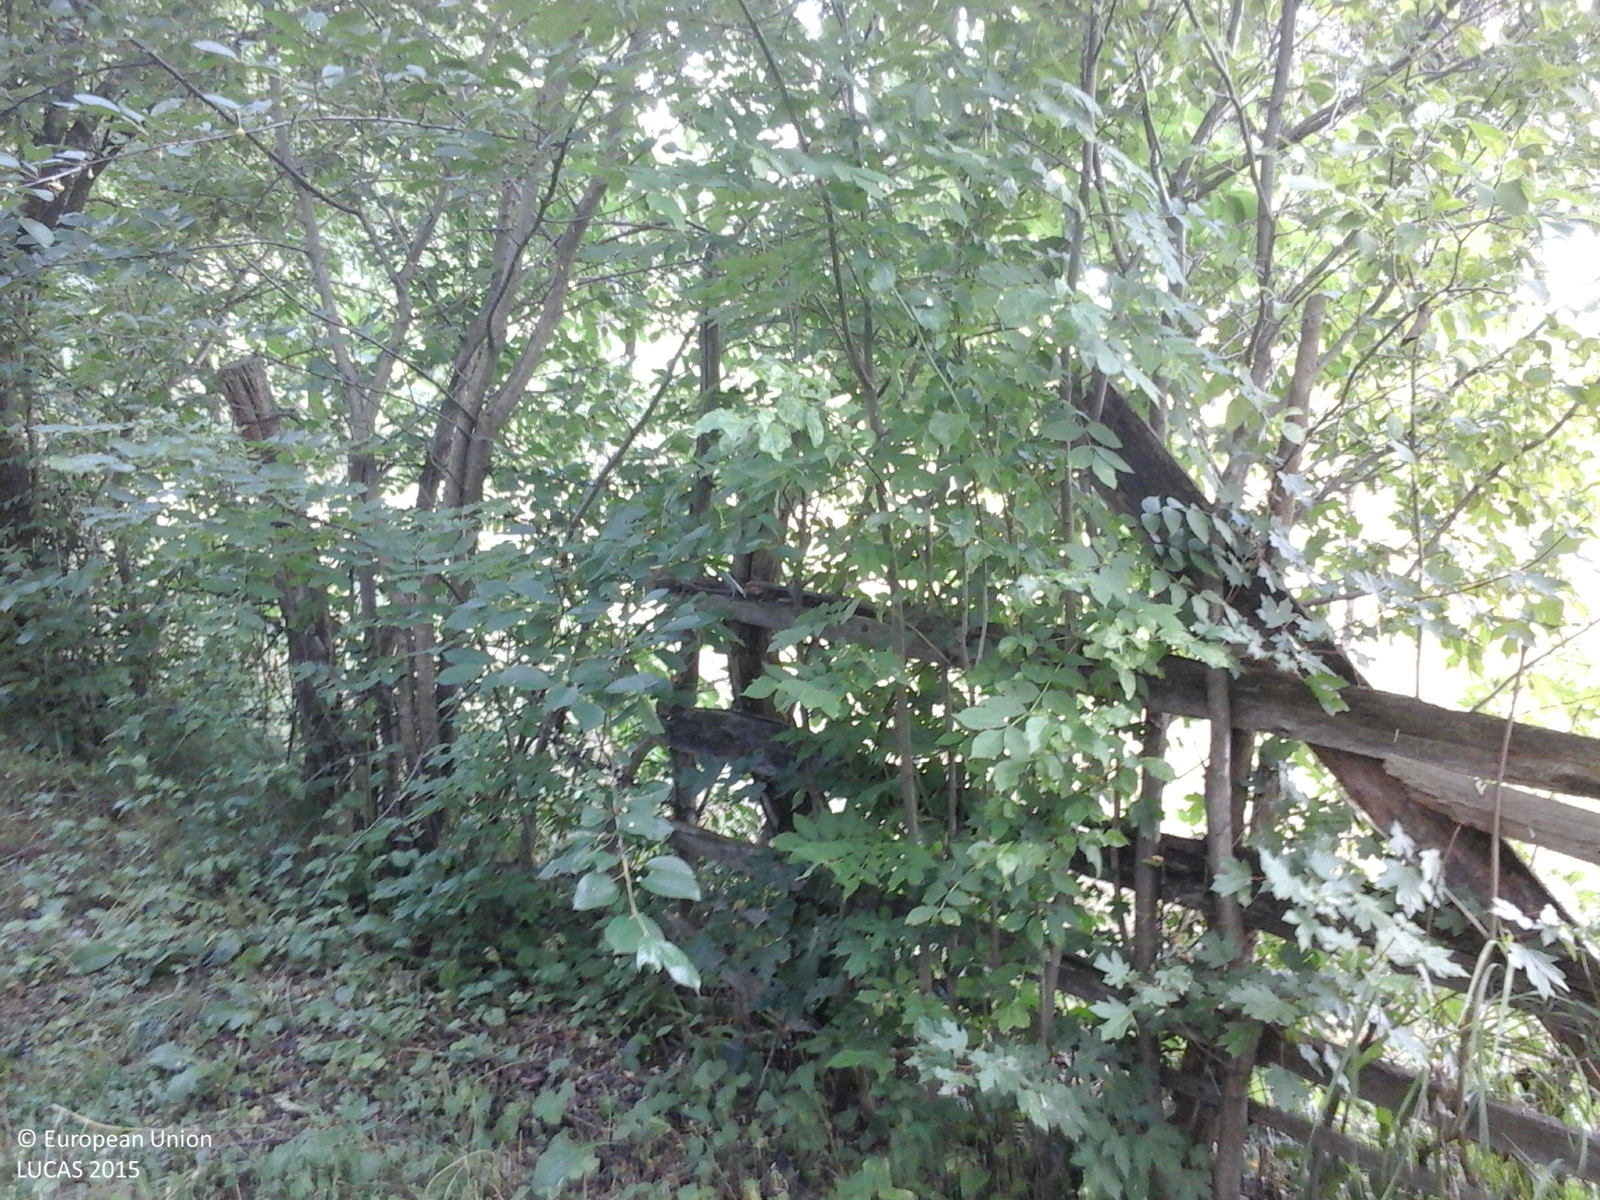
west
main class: Woodland
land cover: Broadleaved woodland
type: exotic forest
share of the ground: > 75 %
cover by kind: broadleaved forest trees 100 %
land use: Forestry
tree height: > 5 m
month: June
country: RO
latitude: 47.1052
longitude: 26.3288
